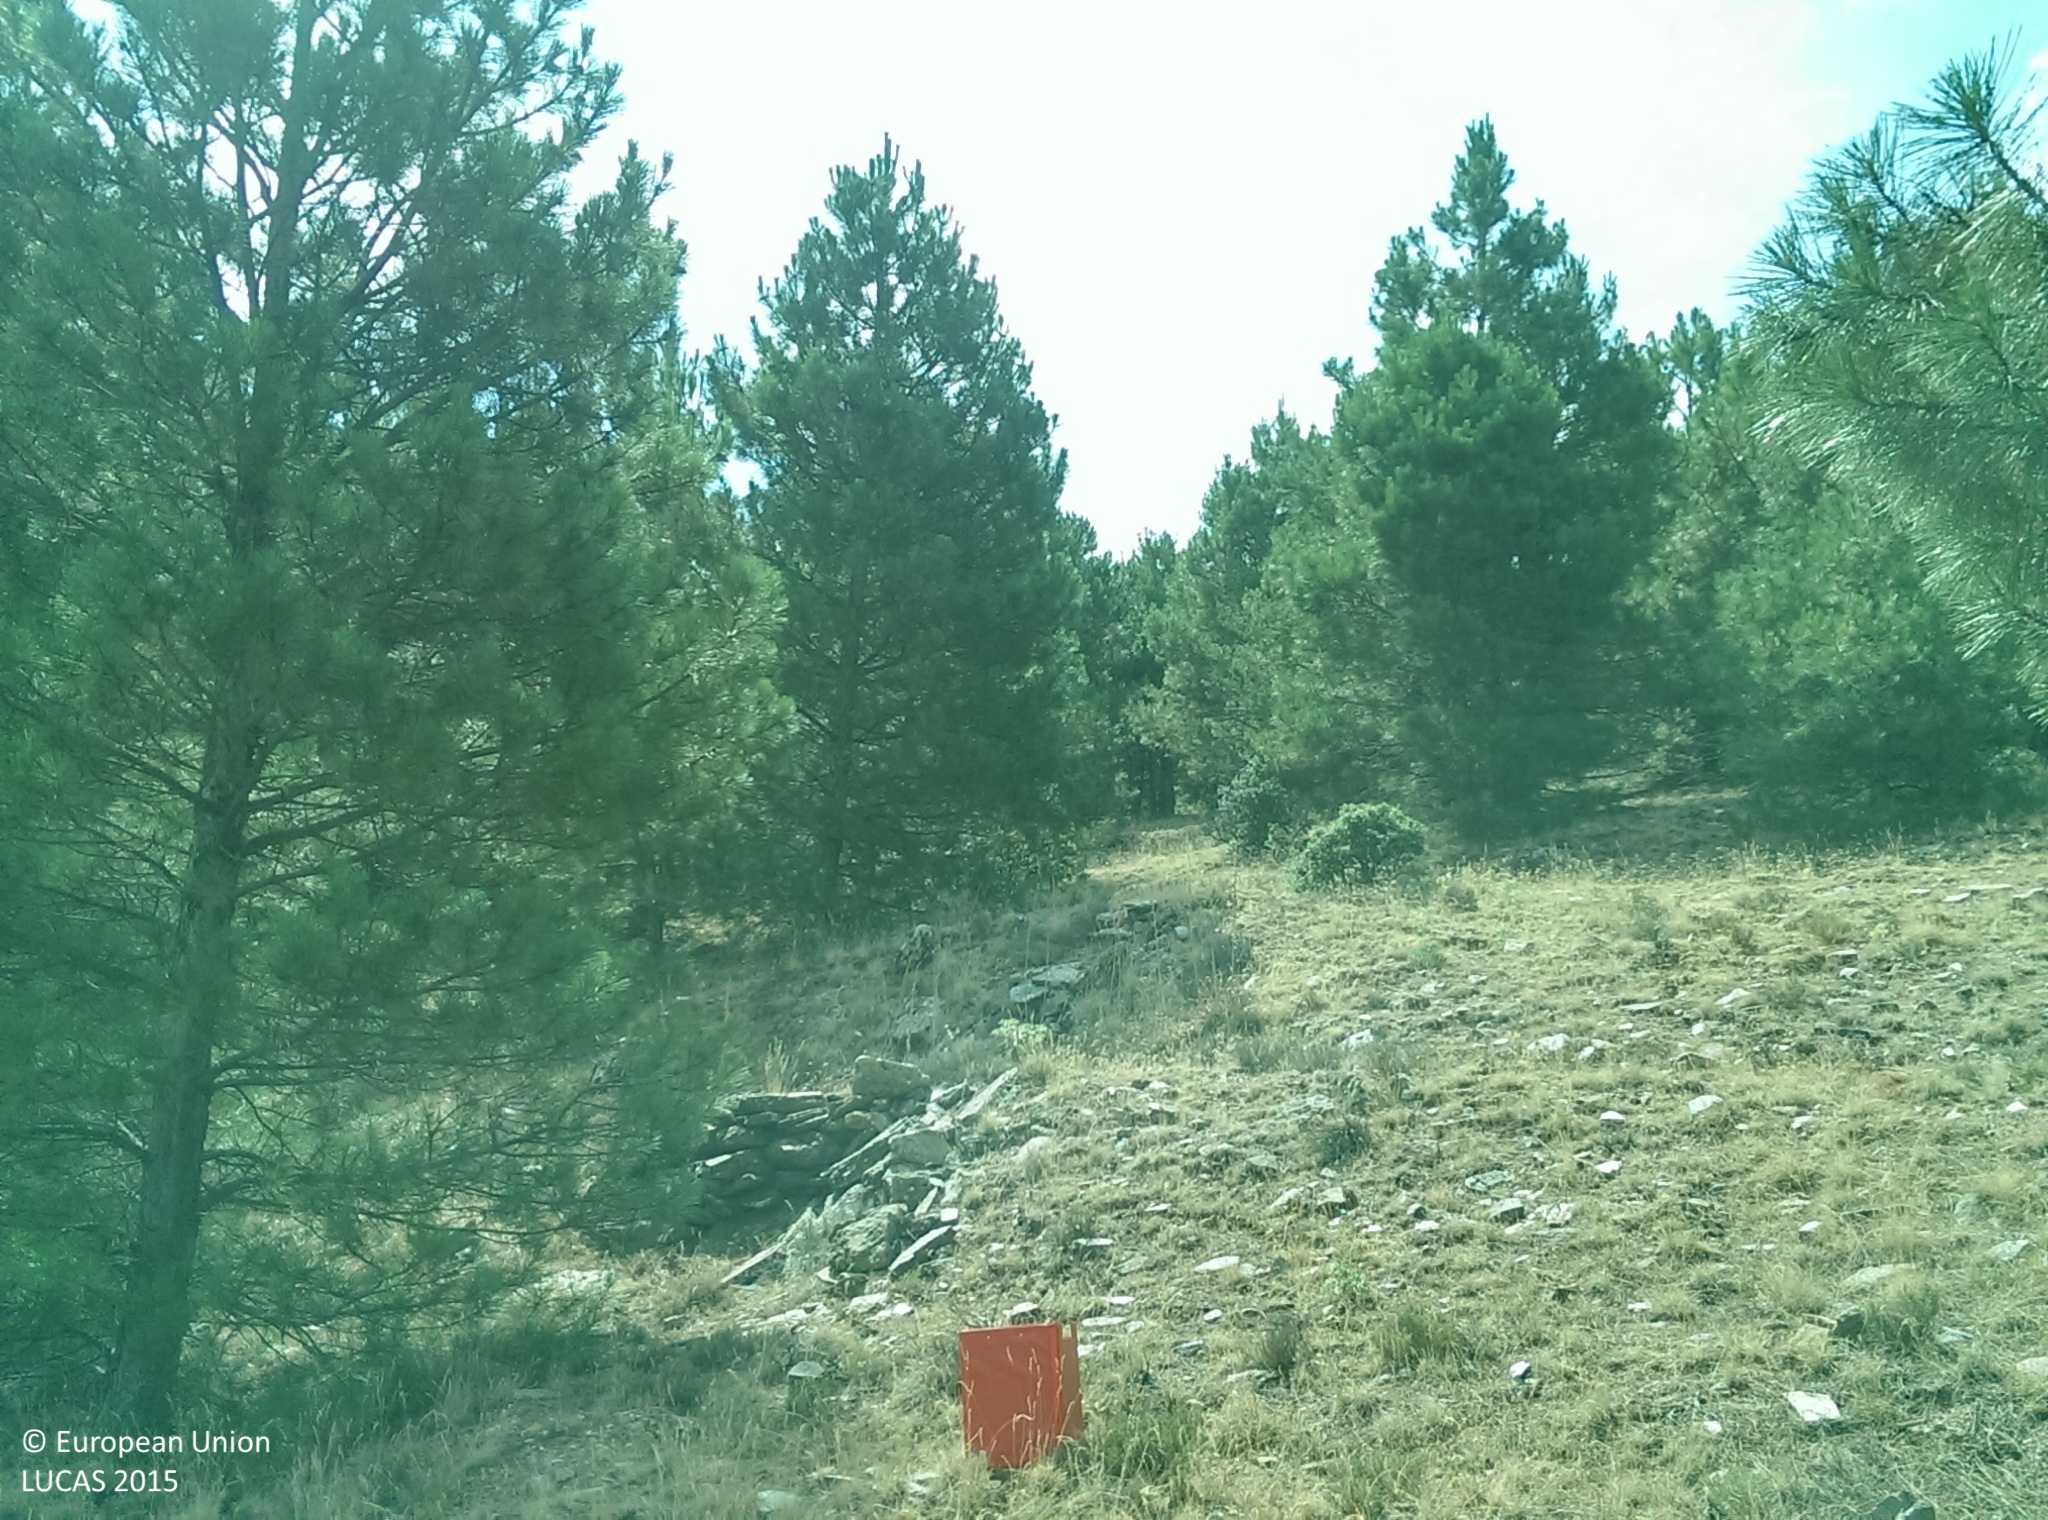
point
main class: Woodland
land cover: Pine dominated coniferous woodland
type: coniferous forest of the mediterranean region
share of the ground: 50 - 75 %
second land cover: Grassland without tree/shrub cover
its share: 25 - 50 %
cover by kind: coniferous forest trees 50 %, herbaceous plants 30 %, shrubs 10 %, unconsolidated bare surface 10 %
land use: Forestry
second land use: Agriculture (excluding fallow land and kitchen gardens)
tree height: > 5 m
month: July
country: ES
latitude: 37.3016
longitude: -2.9255
